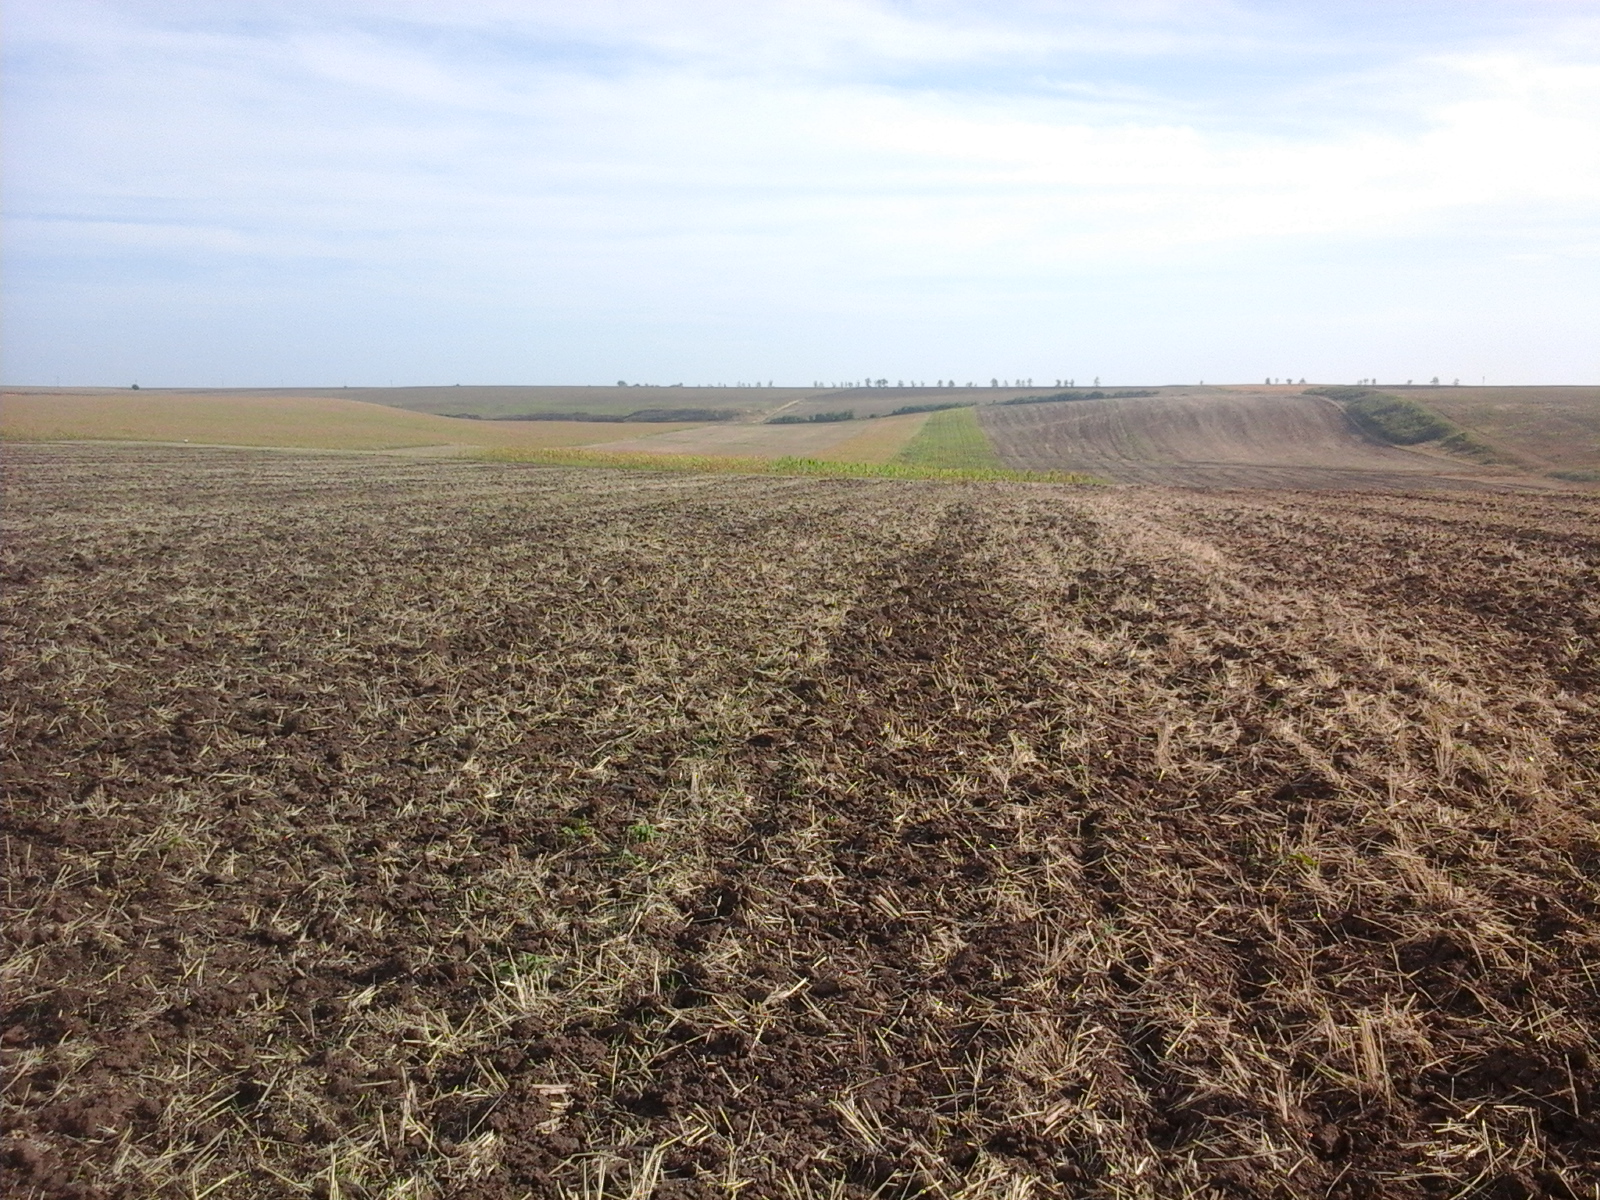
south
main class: Cropland
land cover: Common wheat
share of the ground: < 10 %
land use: Agriculture (excluding fallow land and kitchen gardens)
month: October
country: RO
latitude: 46.0575
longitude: 21.3175
